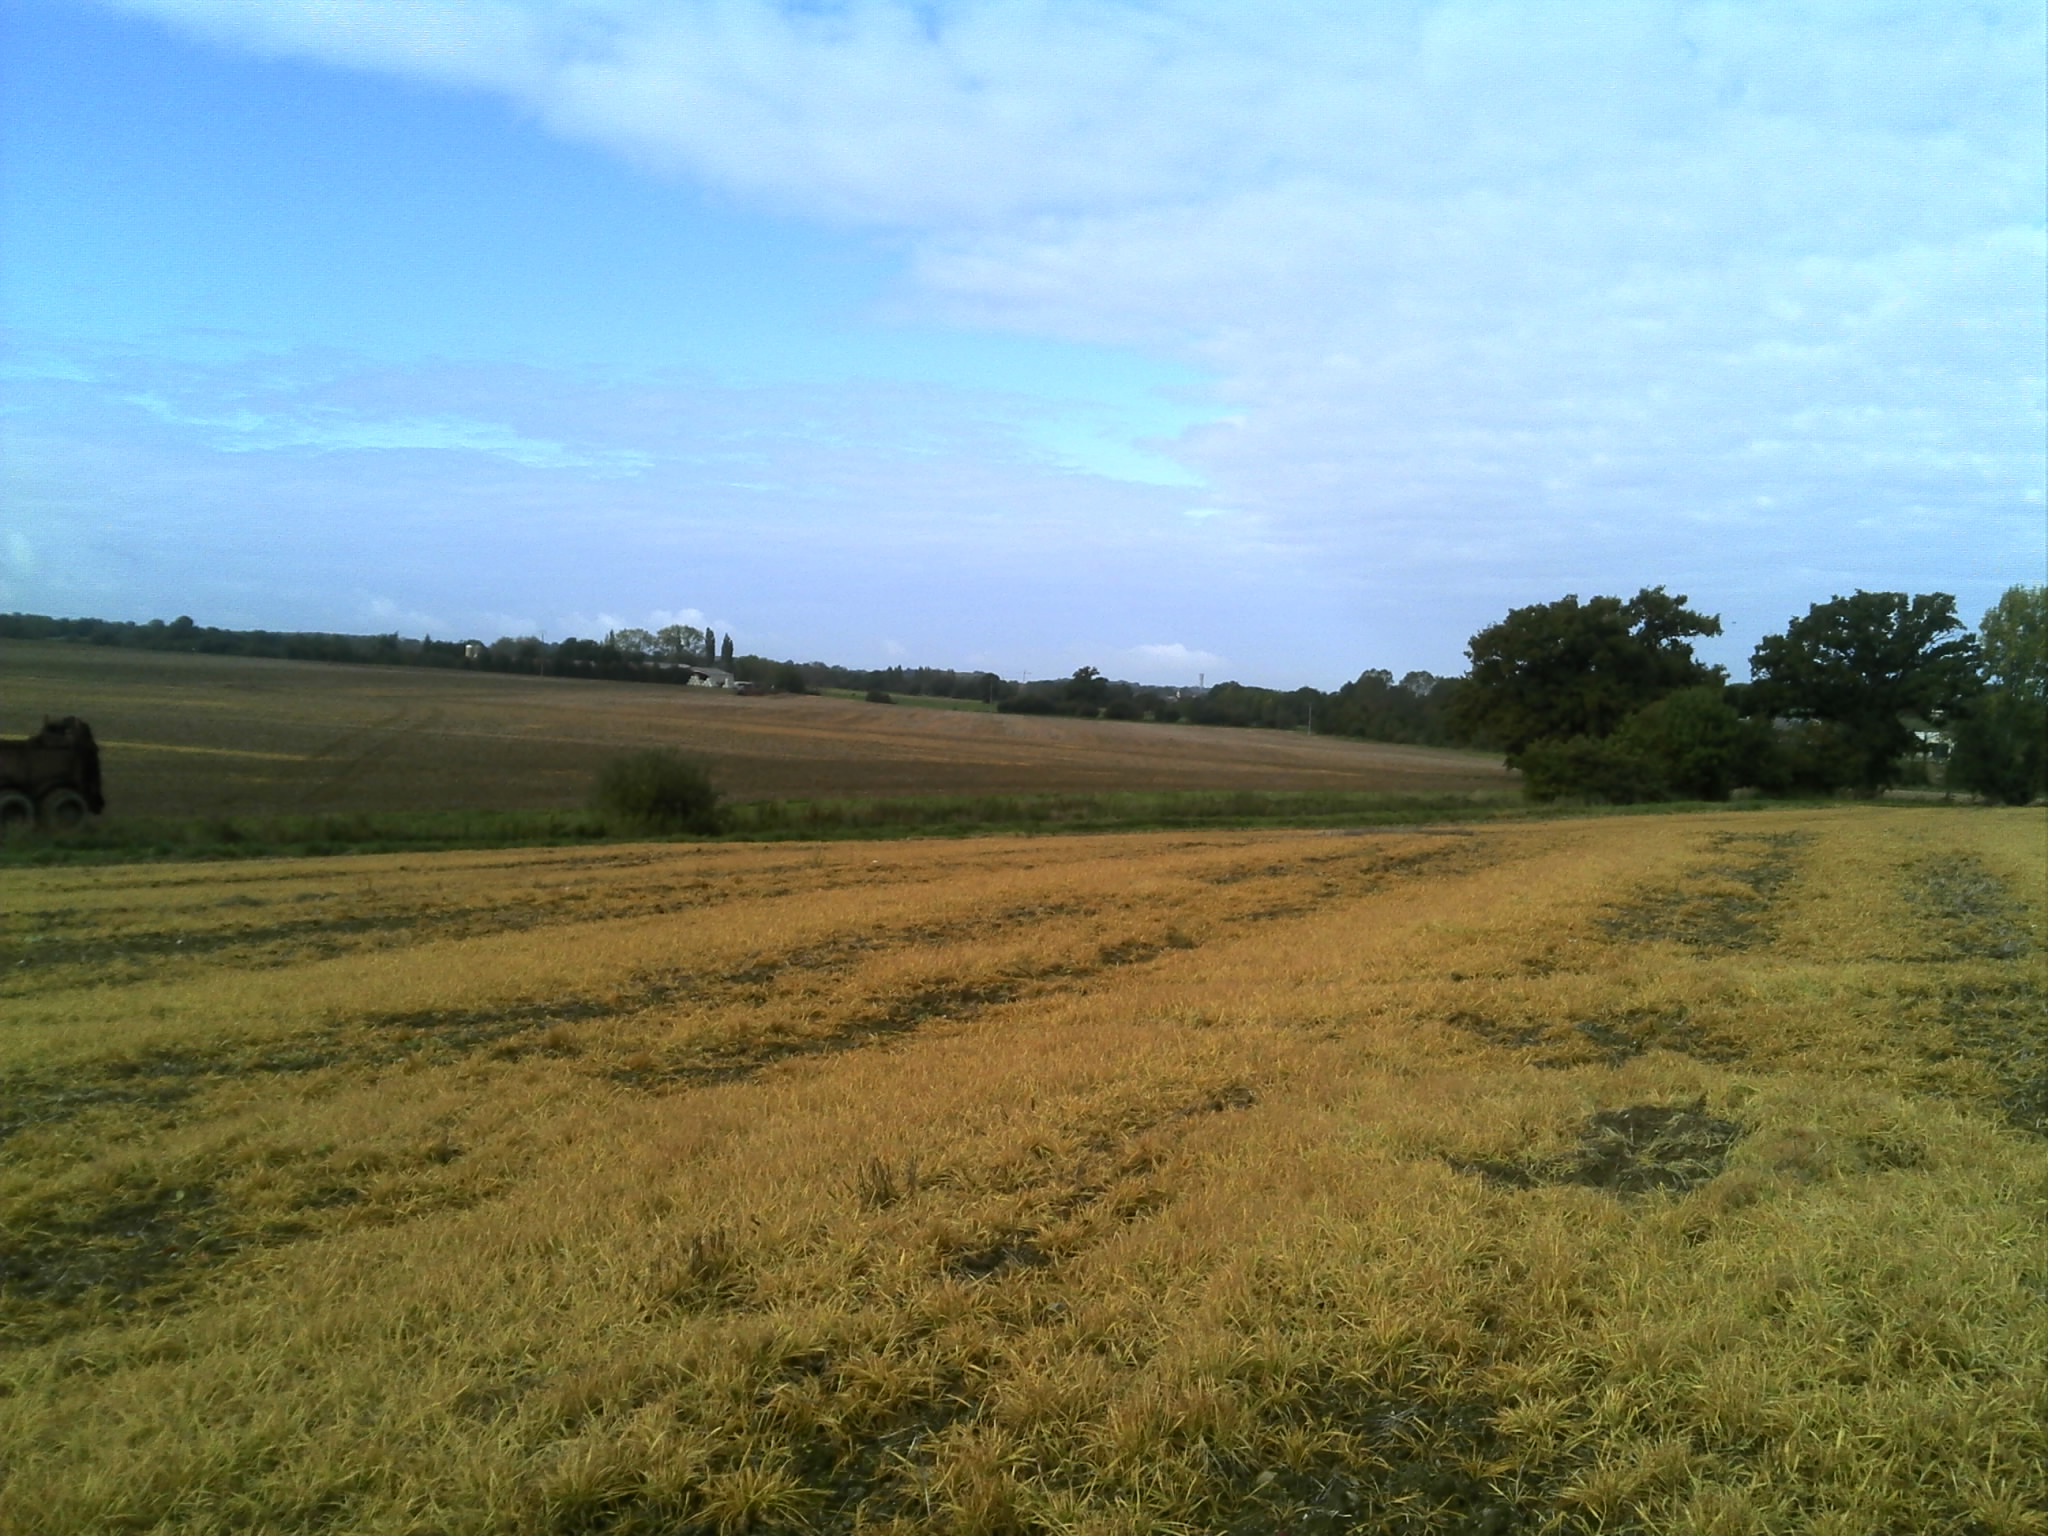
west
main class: Cropland
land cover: Common wheat
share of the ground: > 75 %
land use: Agriculture (excluding fallow land and kitchen gardens)
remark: Harvested field
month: October
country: FR
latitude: 47.7576
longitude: -1.0442
